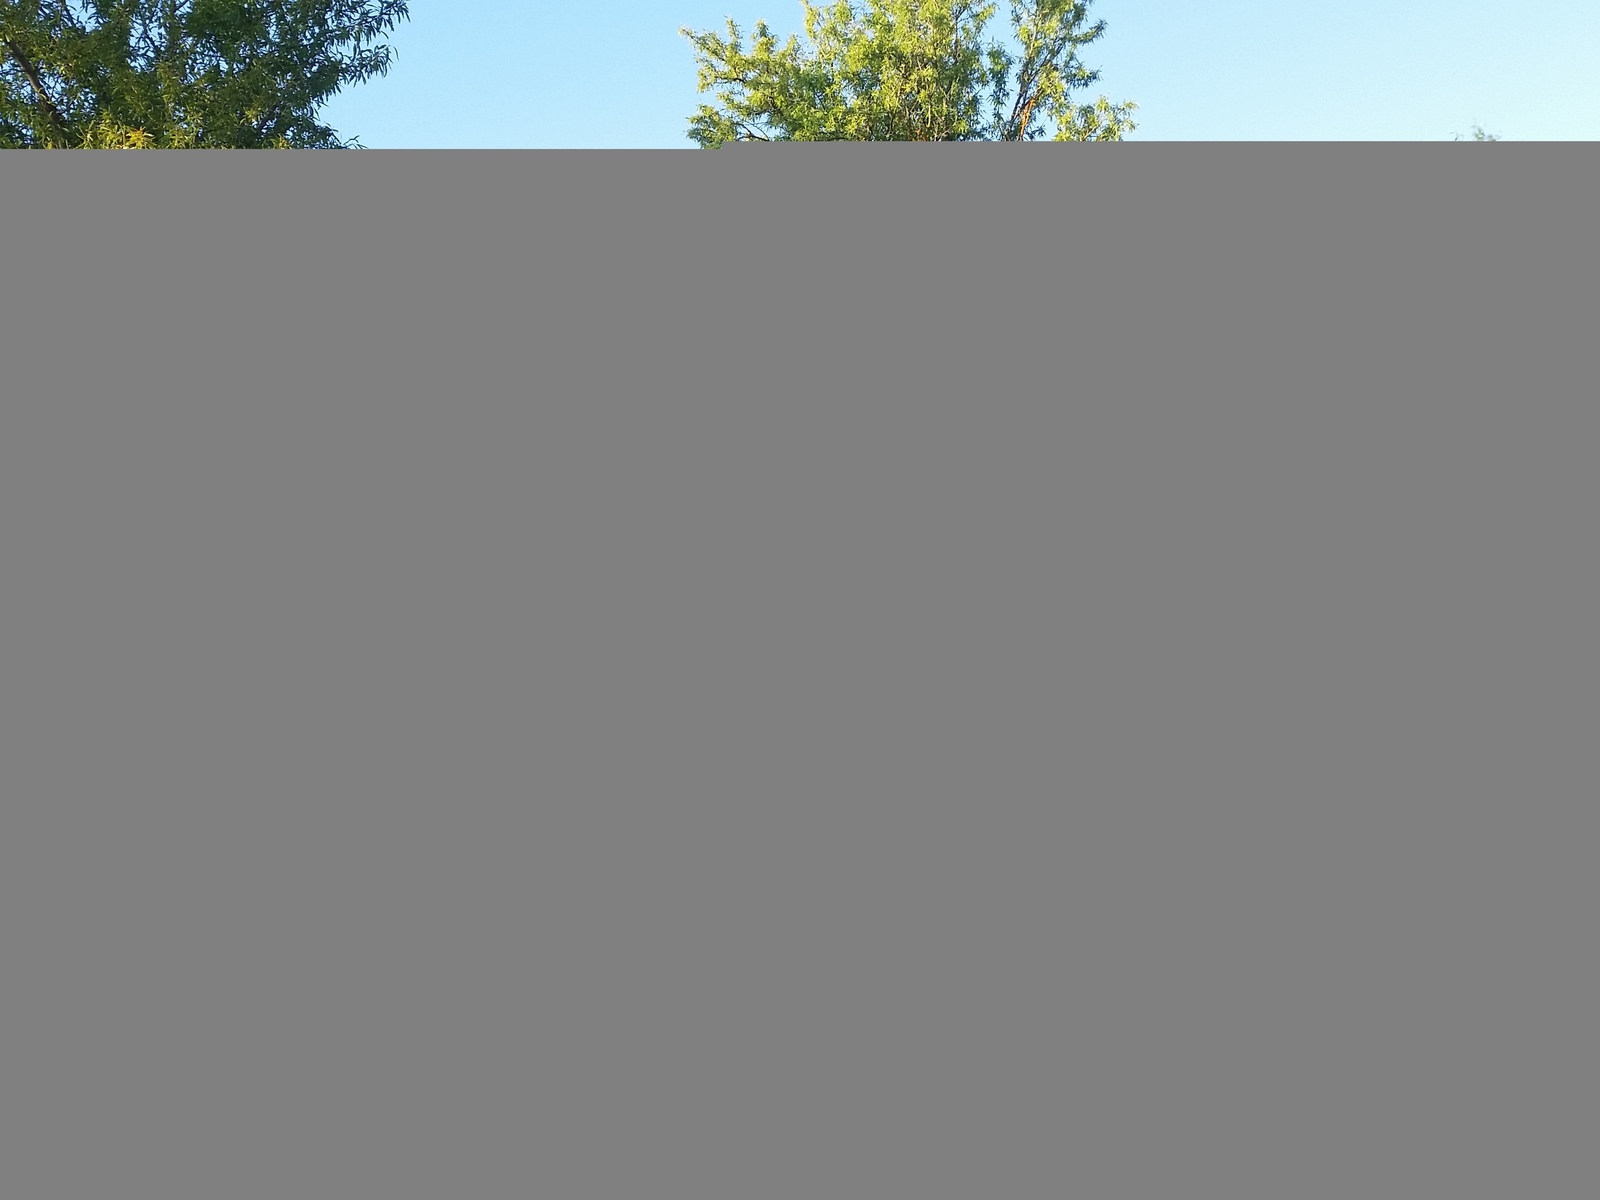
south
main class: Cropland
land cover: Nuts trees
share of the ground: > 75 %
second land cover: Grassland without tree/shrub cover
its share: 25 - 50 %
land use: Agriculture (excluding fallow land and kitchen gardens)
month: July
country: ES
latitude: 38.9669
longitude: -2.5278
